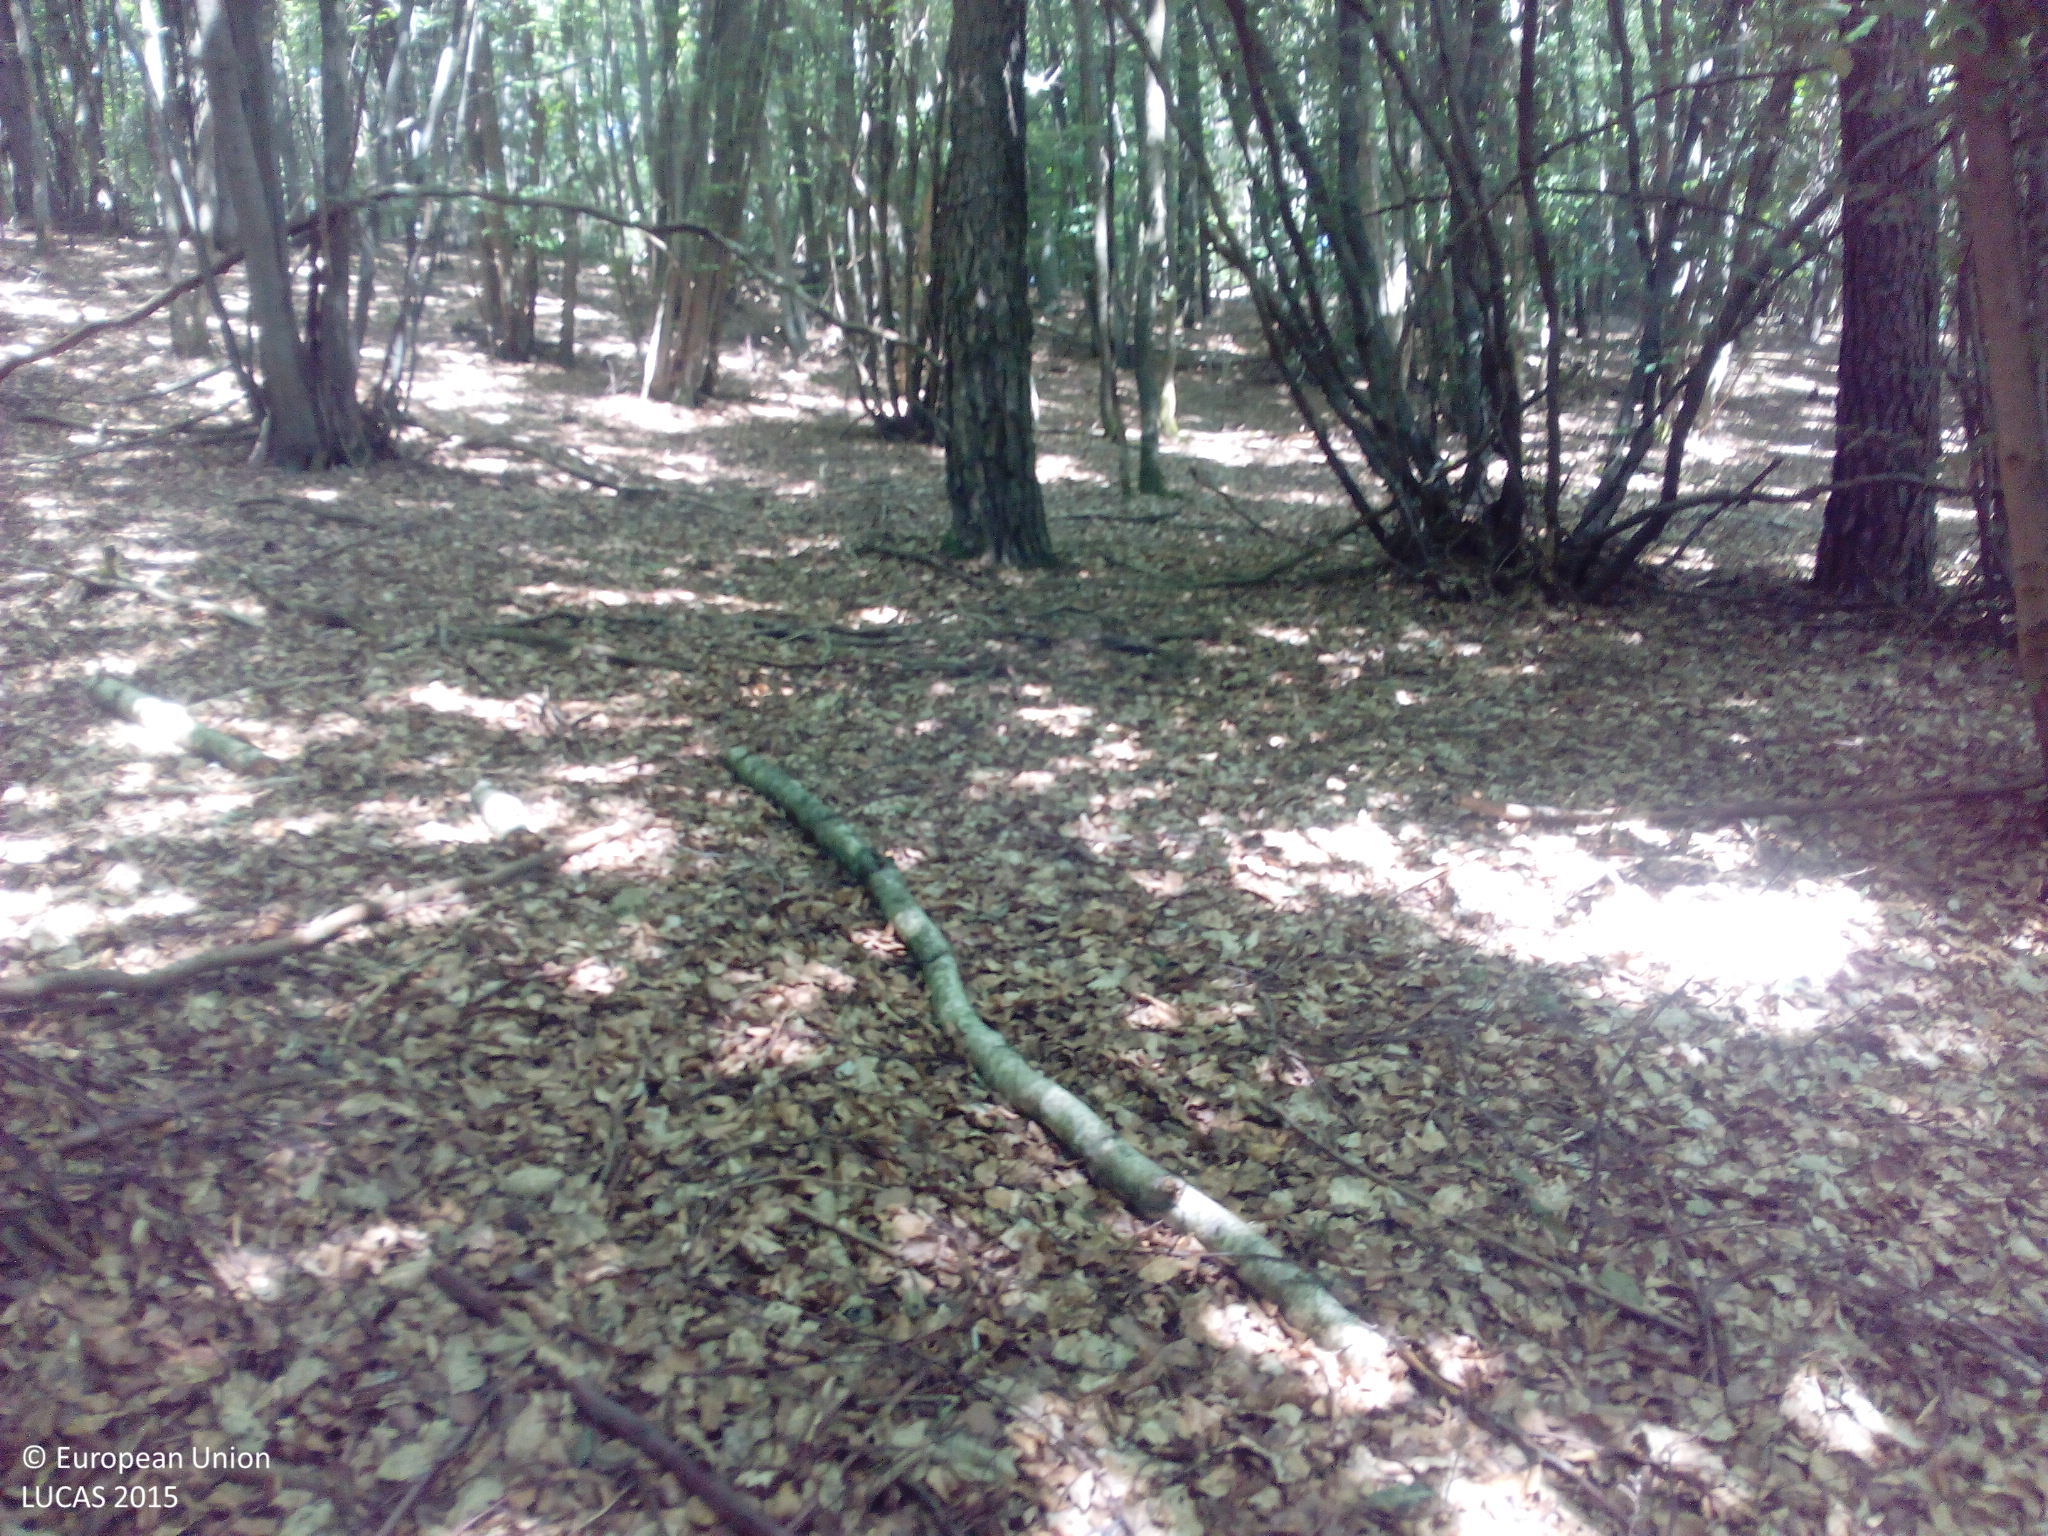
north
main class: Woodland
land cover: Broadleaved woodland
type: mesophytic deciduous forest
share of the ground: > 75 %
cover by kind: broadleaved forest trees 95 %, coniferous forest trees 5 %
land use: Forestry
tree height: > 5 m
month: July
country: DE
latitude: 49.6278
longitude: 7.1899
